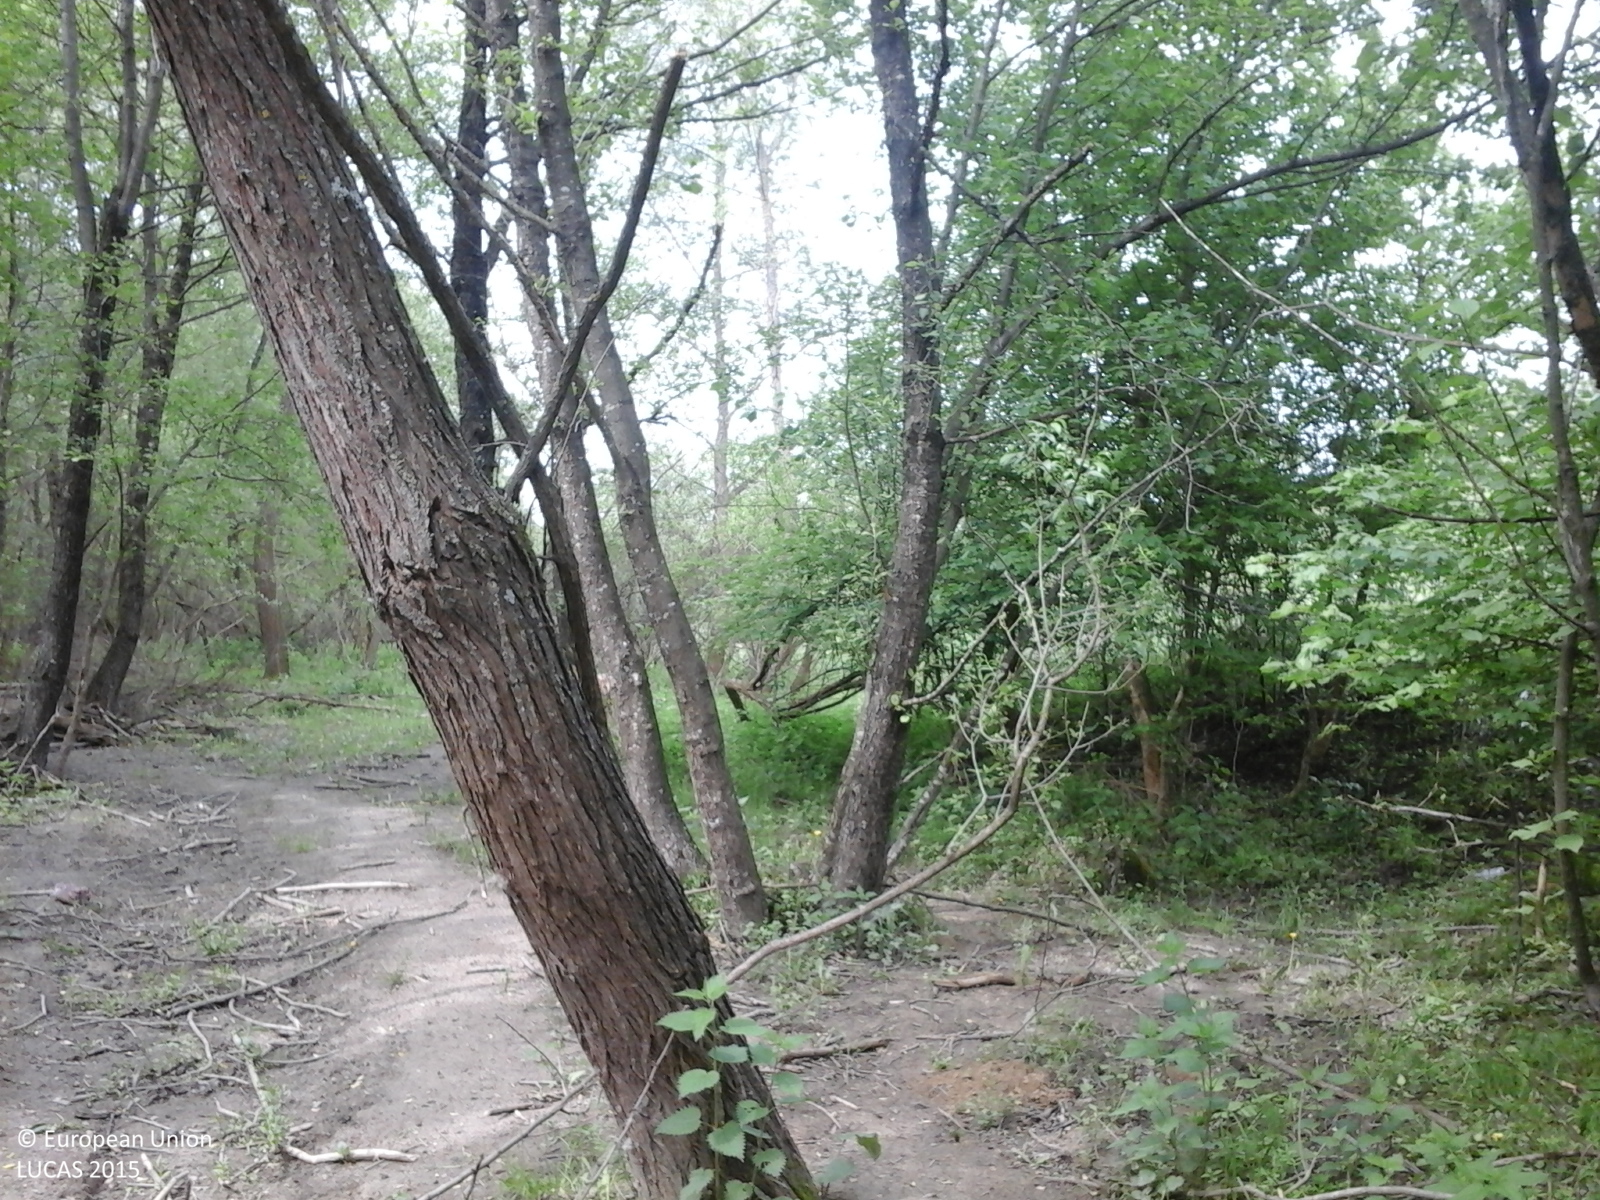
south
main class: Woodland
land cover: Broadleaved woodland
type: non-riverine alder, birch or aspen forest
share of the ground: > 75 %
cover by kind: broadleaved forest trees 100 %
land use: Forestry
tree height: > 5 m
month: May
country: RO
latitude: 45.8576
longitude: 25.6002
